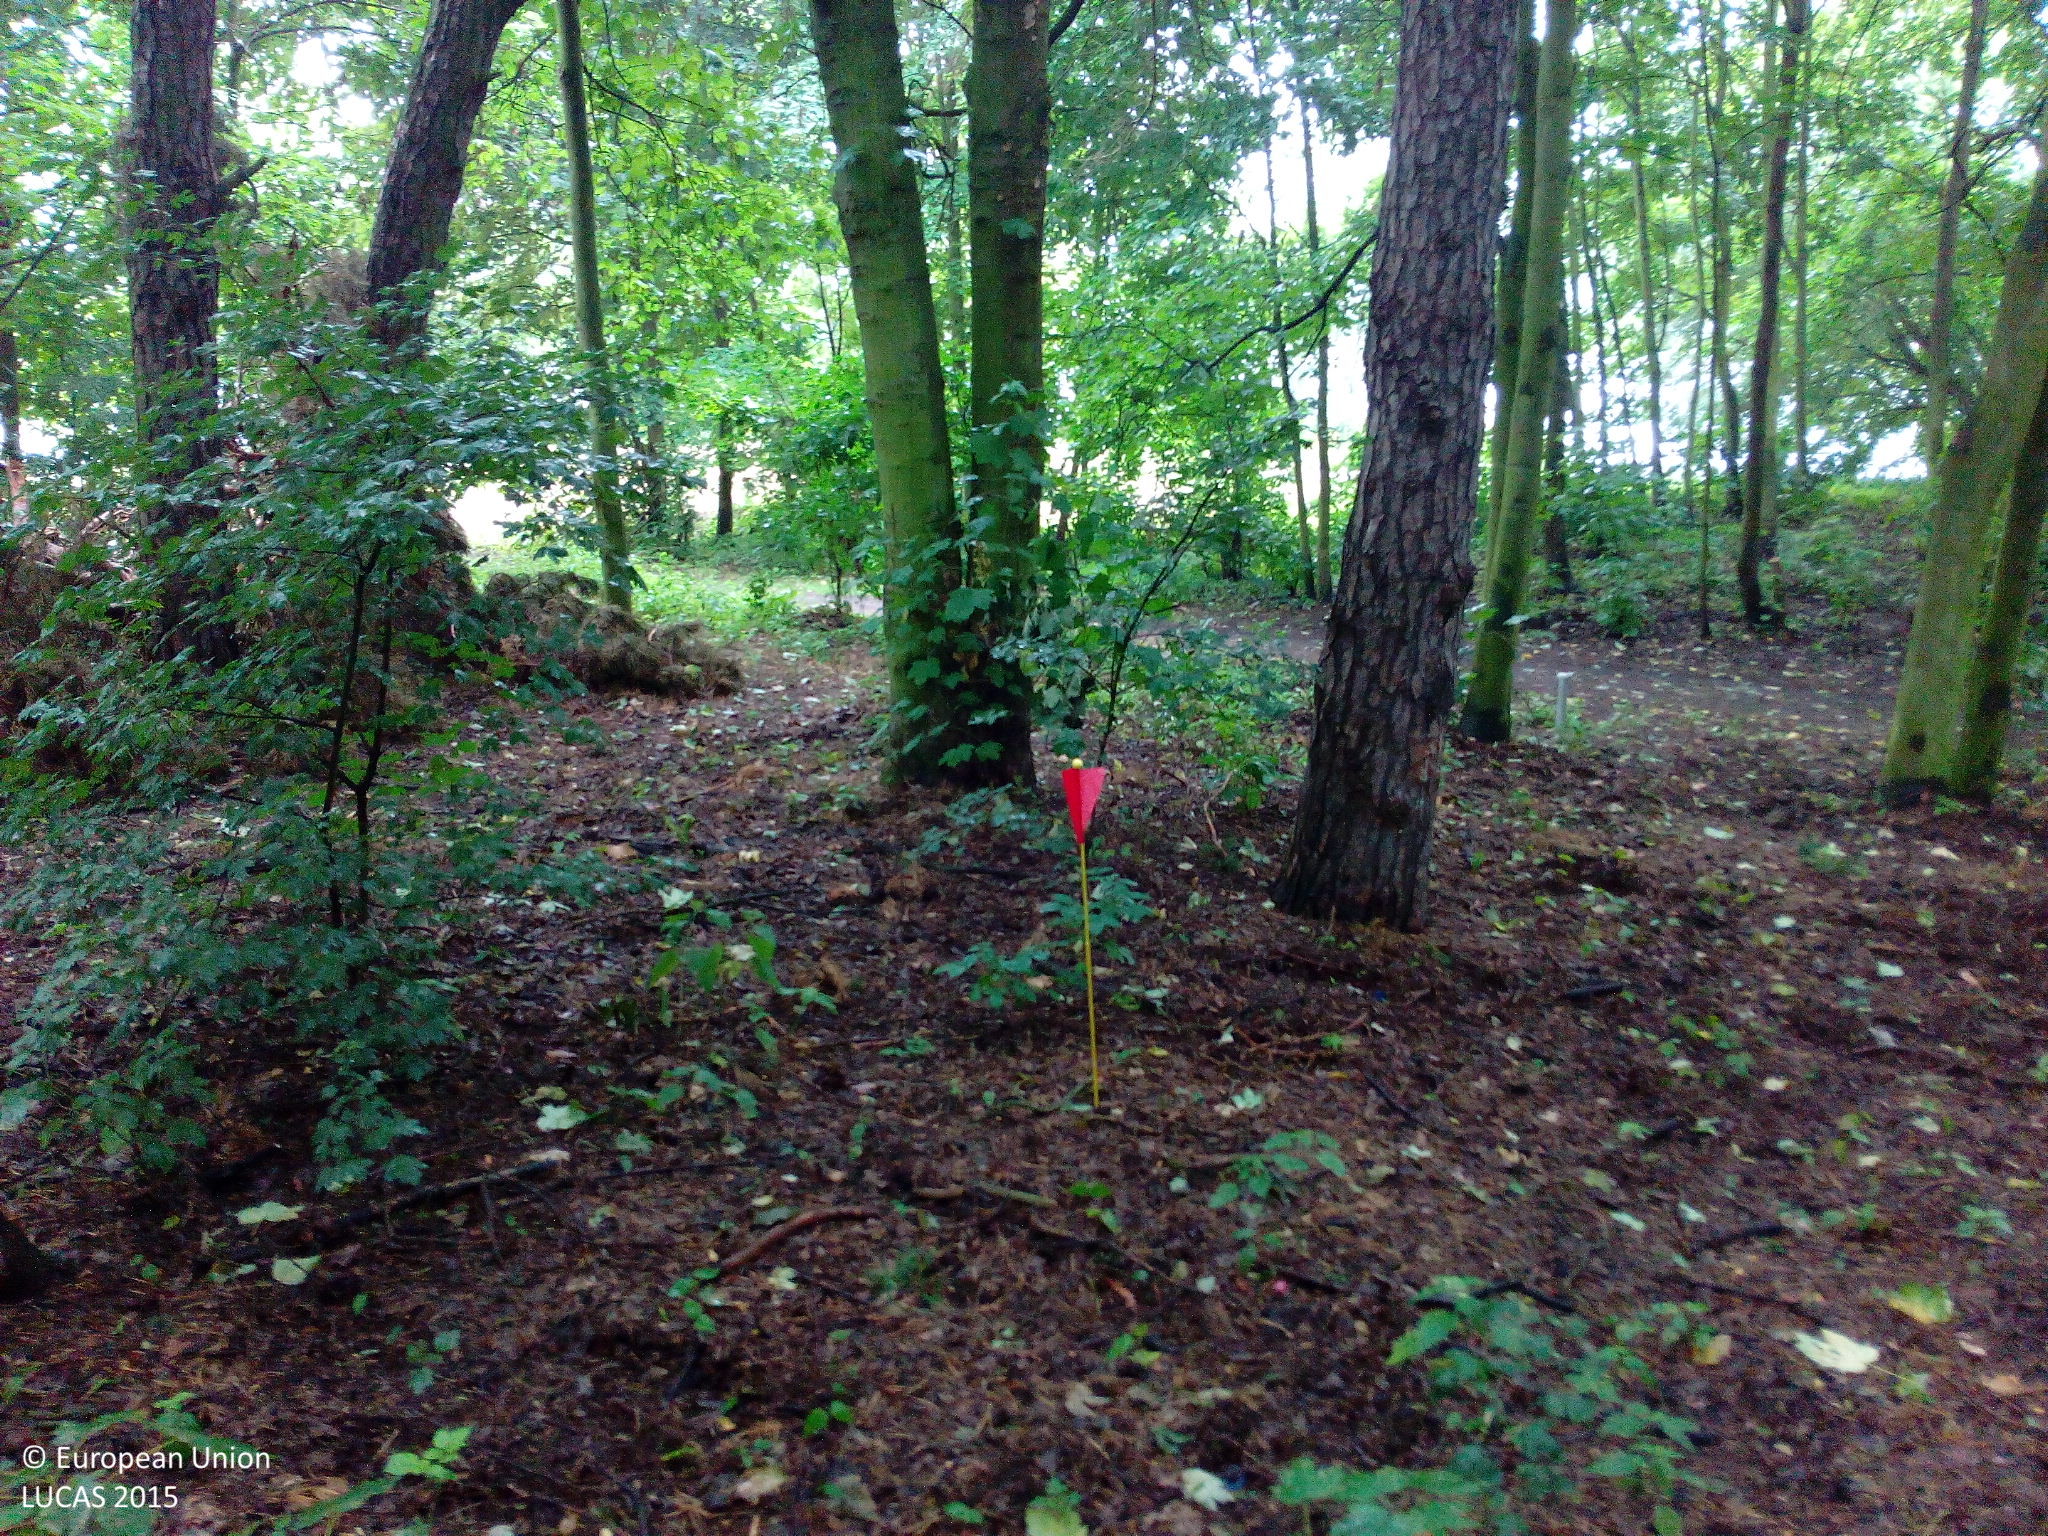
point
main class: Woodland
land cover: Broadleaved woodland
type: mesophytic deciduous forest
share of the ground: > 75 %
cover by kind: broadleaved forest trees 100 %
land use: Forestry
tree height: > 5 m
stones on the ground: < 10 %
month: July
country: DE
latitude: 52.4964
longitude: 13.1963
